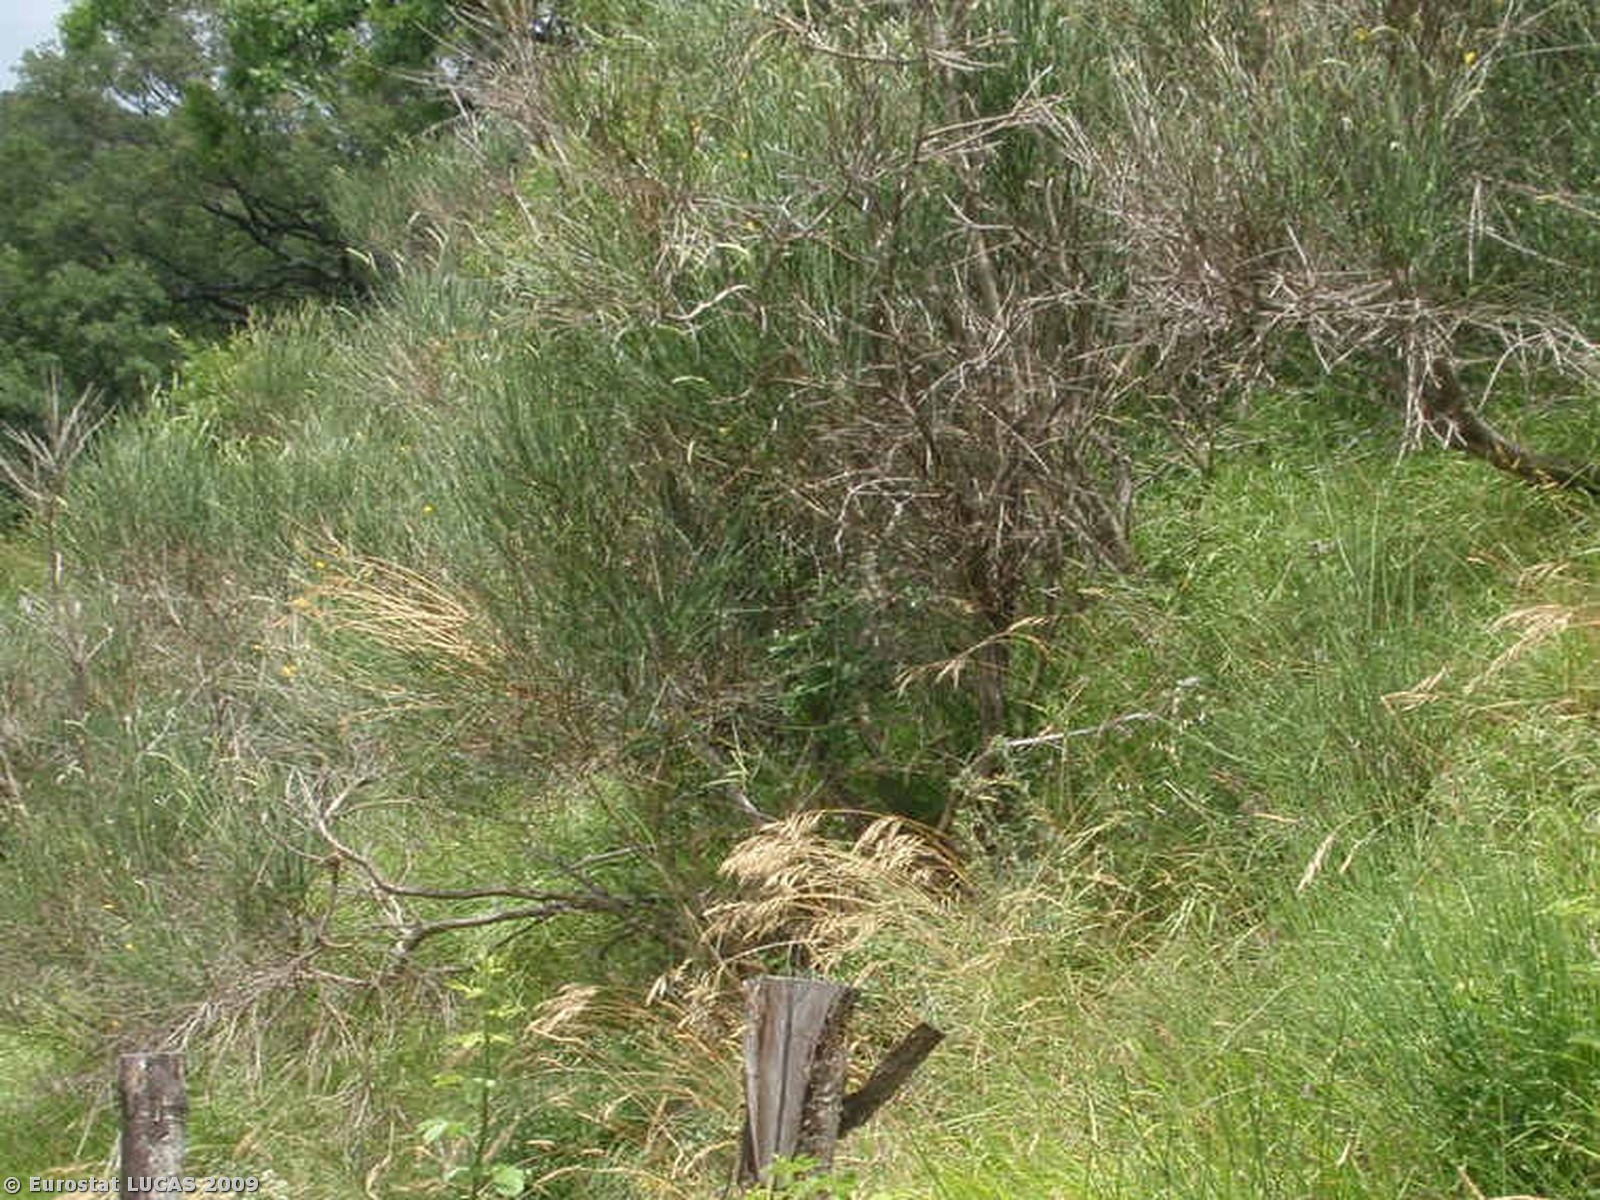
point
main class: Artificial land
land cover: Non built-up linear features
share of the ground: > 75 %
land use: Road transport
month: June
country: IT
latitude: 40.1881
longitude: 16.0708
